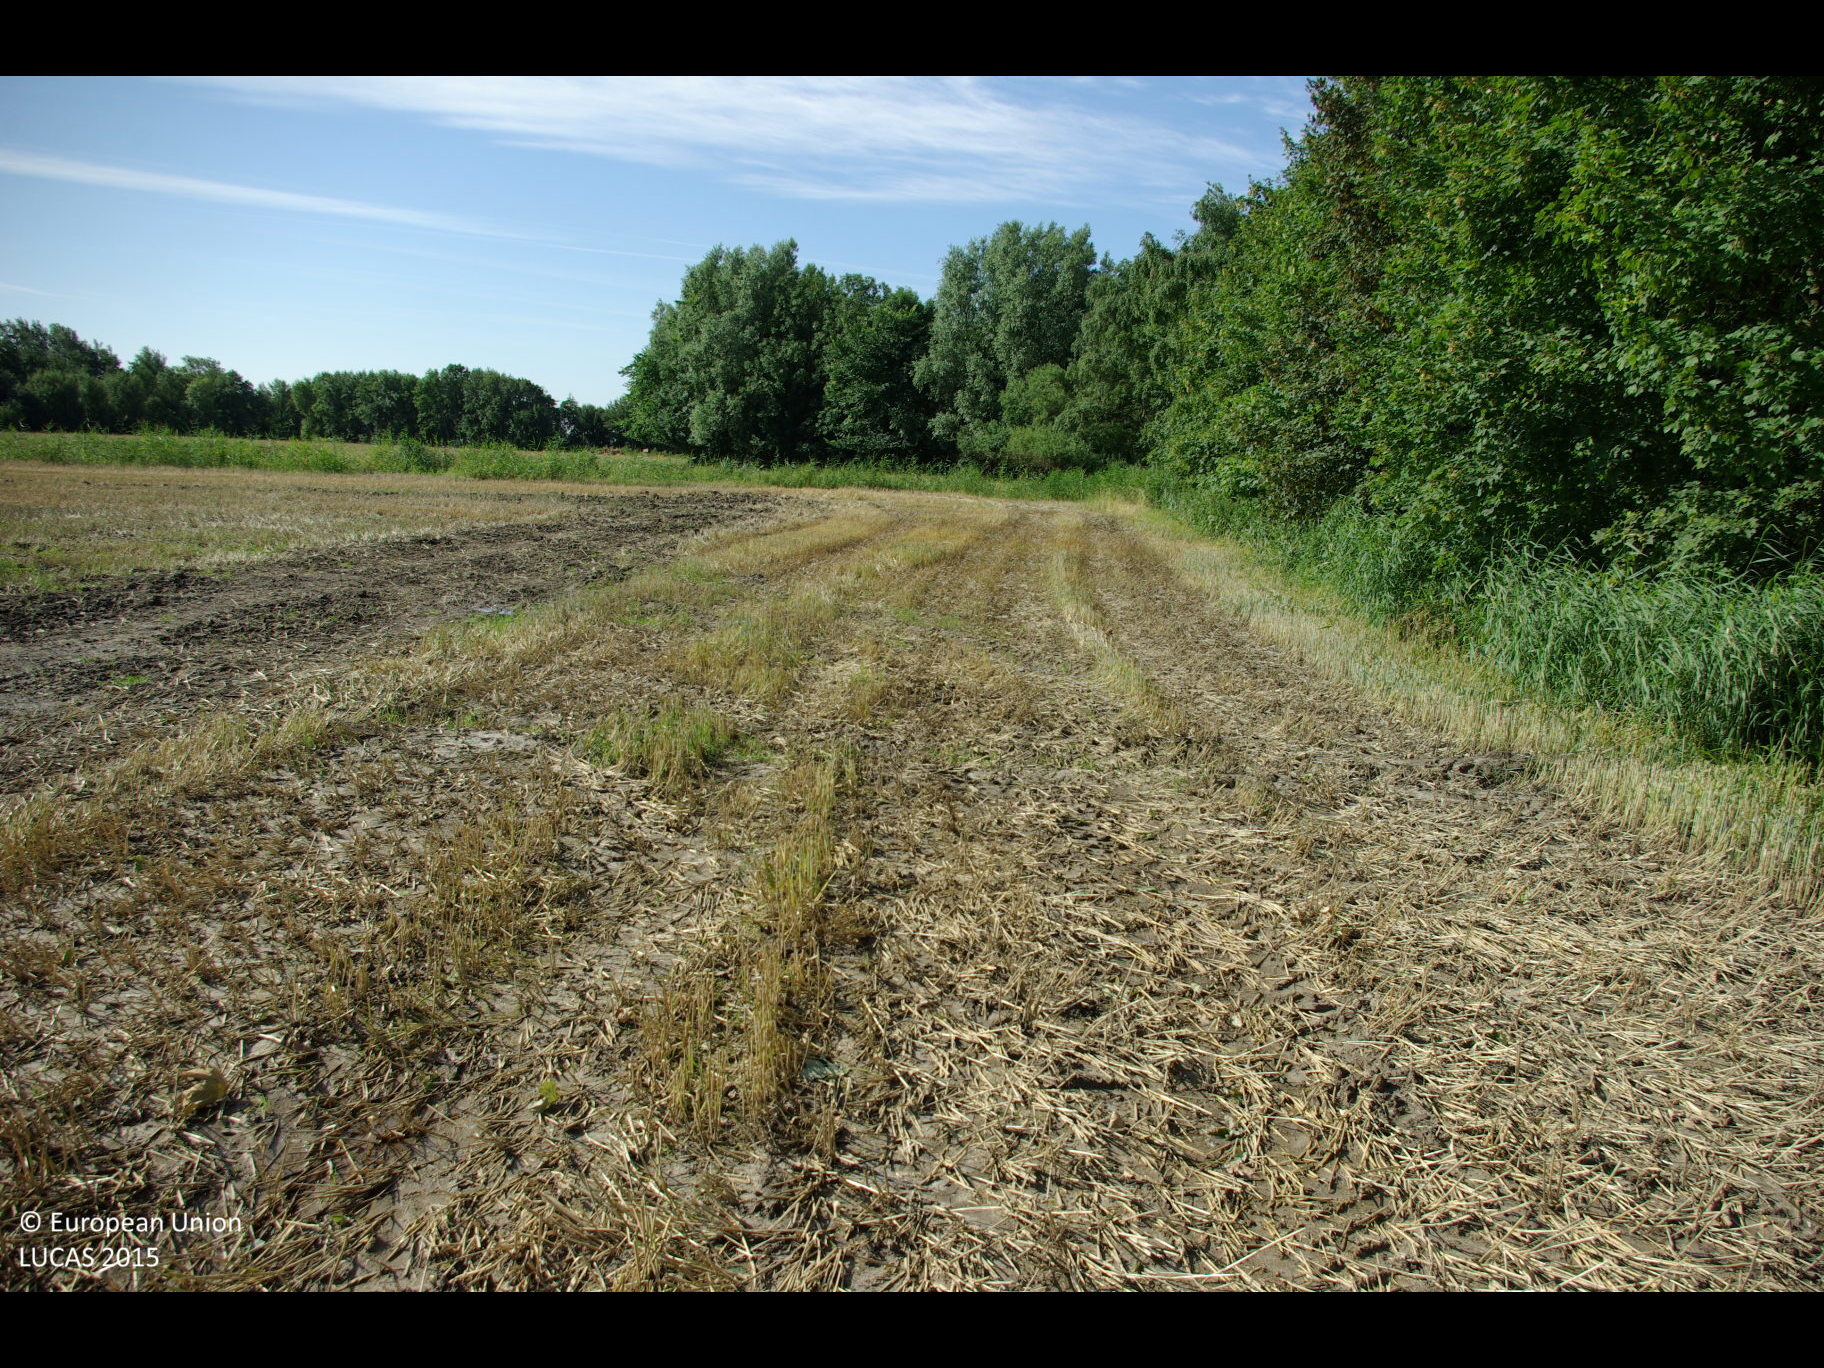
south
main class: Cropland
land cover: Triticale
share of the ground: < 10 %
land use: Agriculture (excluding fallow land and kitchen gardens)
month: August
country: DE
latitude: 54.4048
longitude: 9.0609
